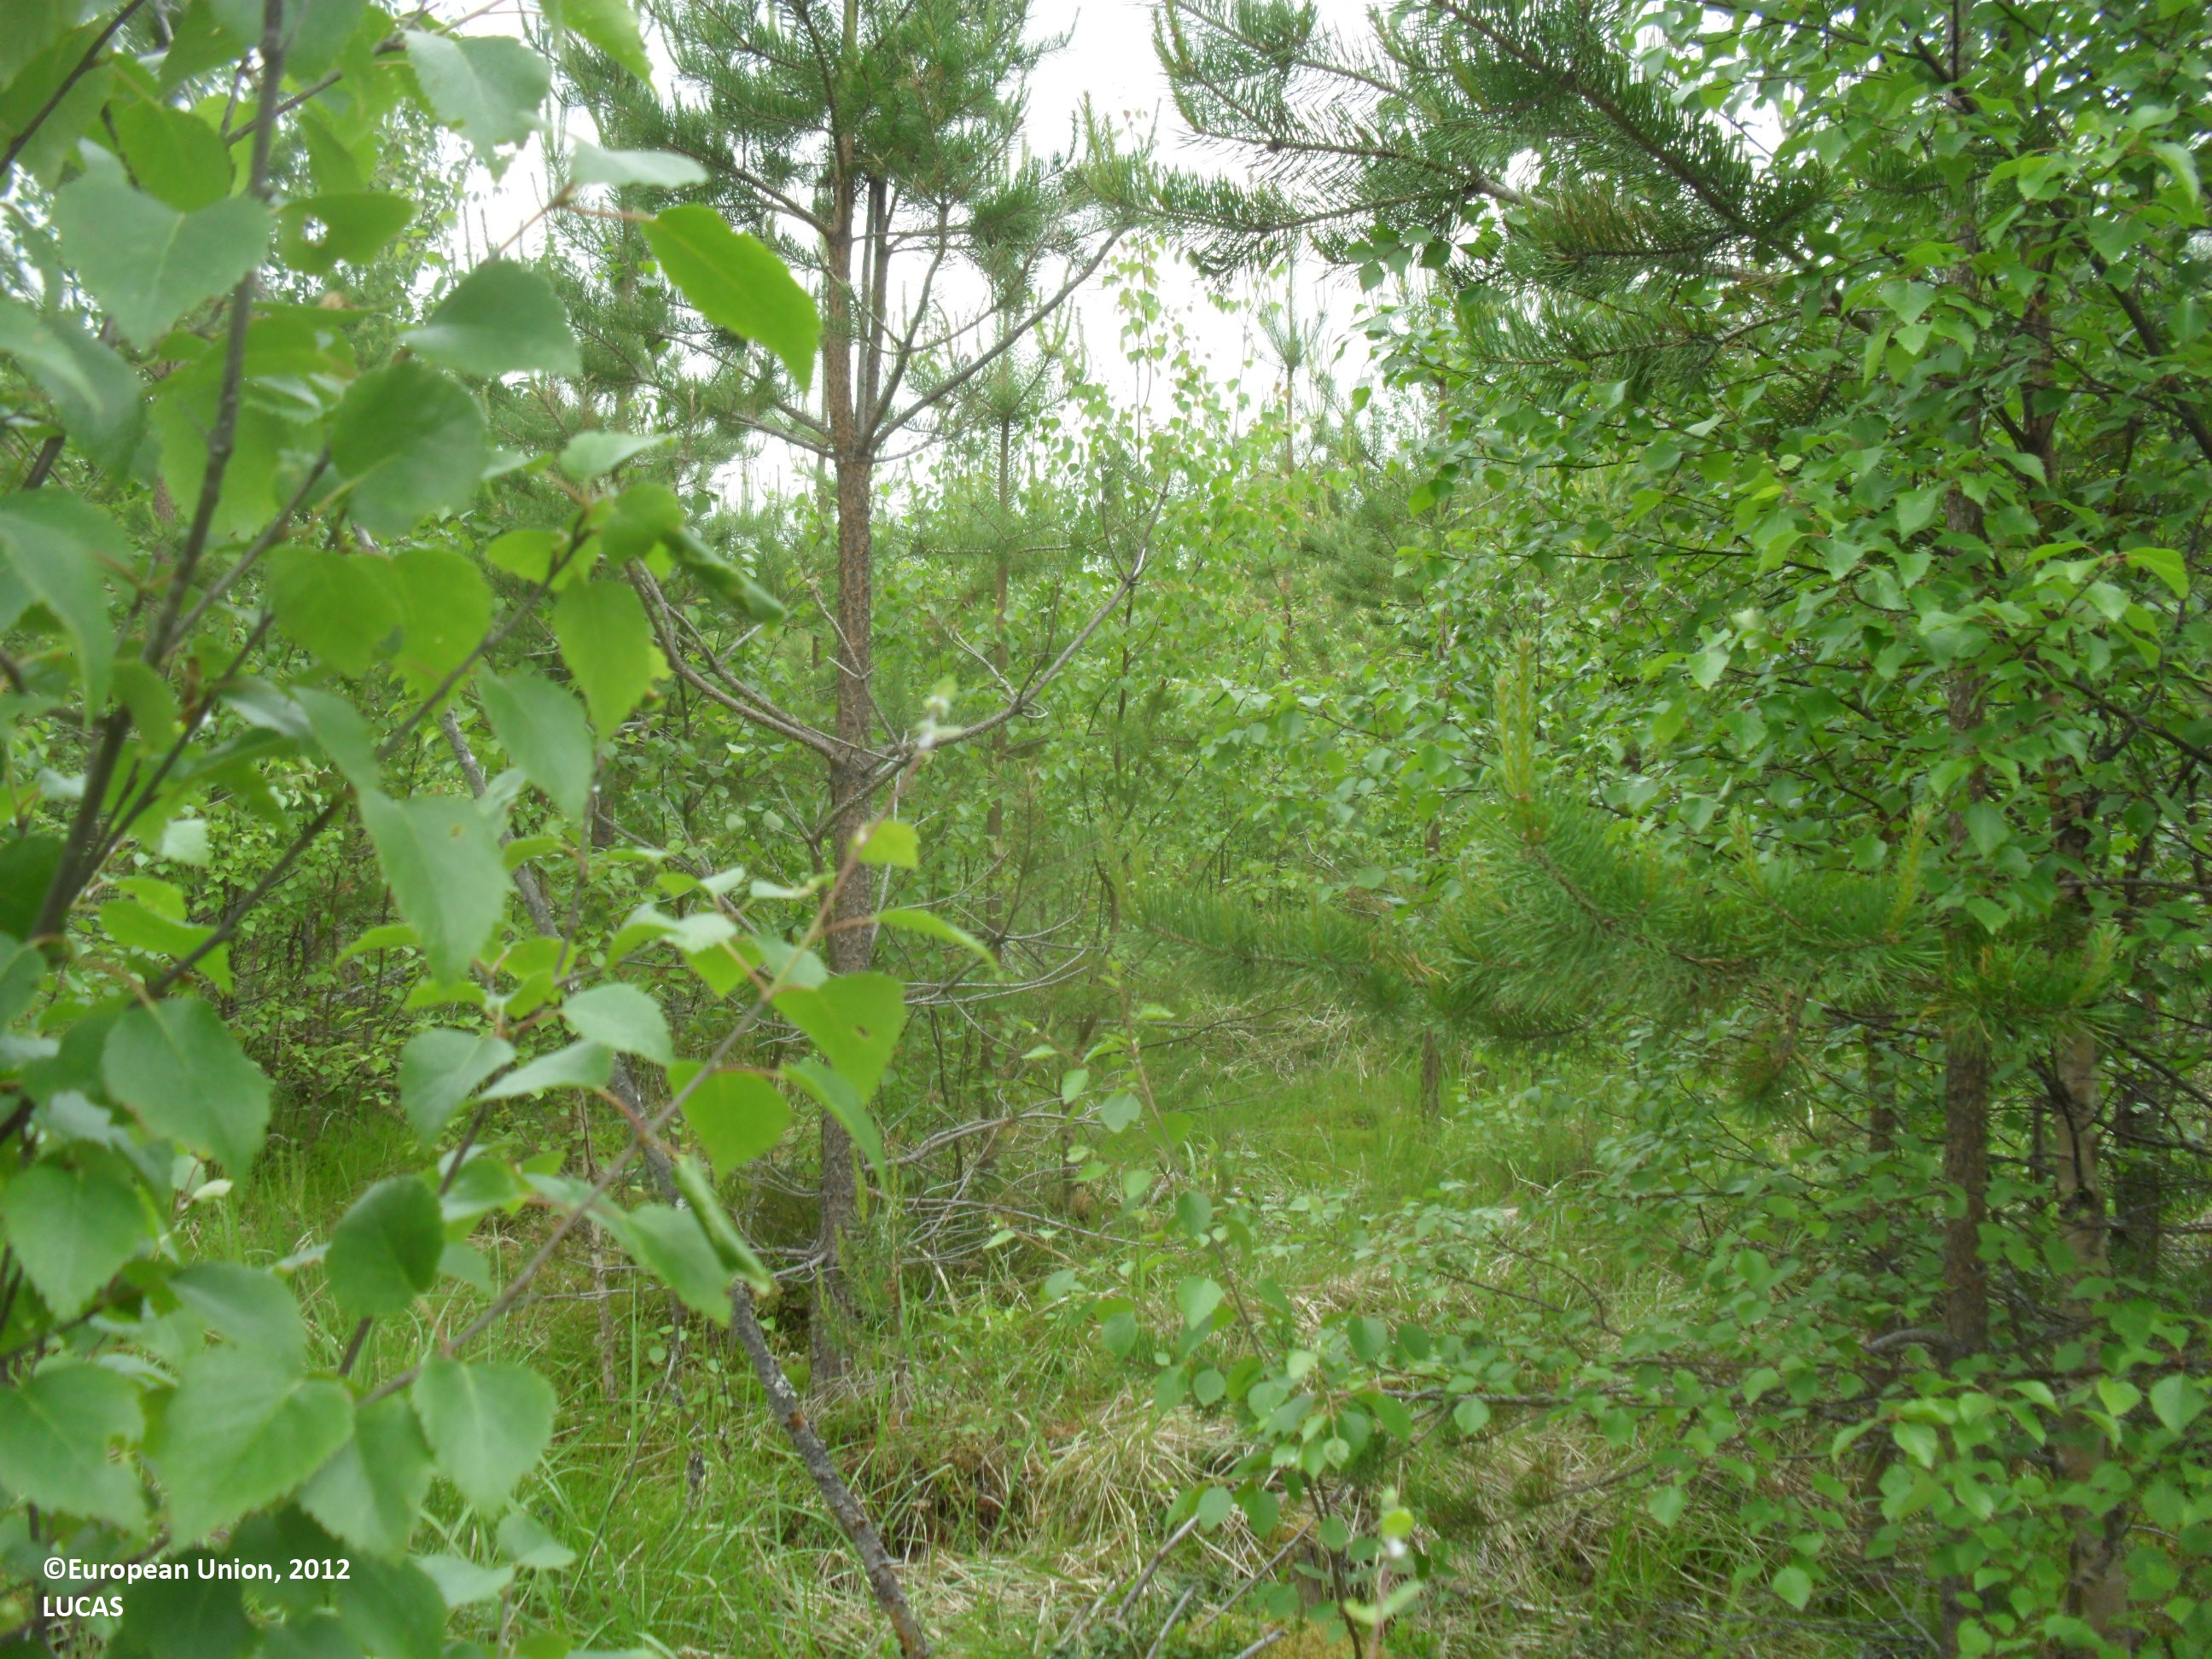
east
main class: Woodland
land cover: Pine dominated mixed woodland
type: boreal forest
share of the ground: 25 - 50 %
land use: Forestry
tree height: < 5 m
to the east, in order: Pine dominated mixed woodland; Other mixed woodland; Pine dominated mixed woodland; Ditches and canals; Paved roads, cycling and walking lanes; Other mixed woodland; Pine dominated mixed woodland; Ditches and canals; Other mixed woodland; Pine dominated mixed woodland
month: June
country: FI
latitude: 63.3999
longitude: 23.6576
